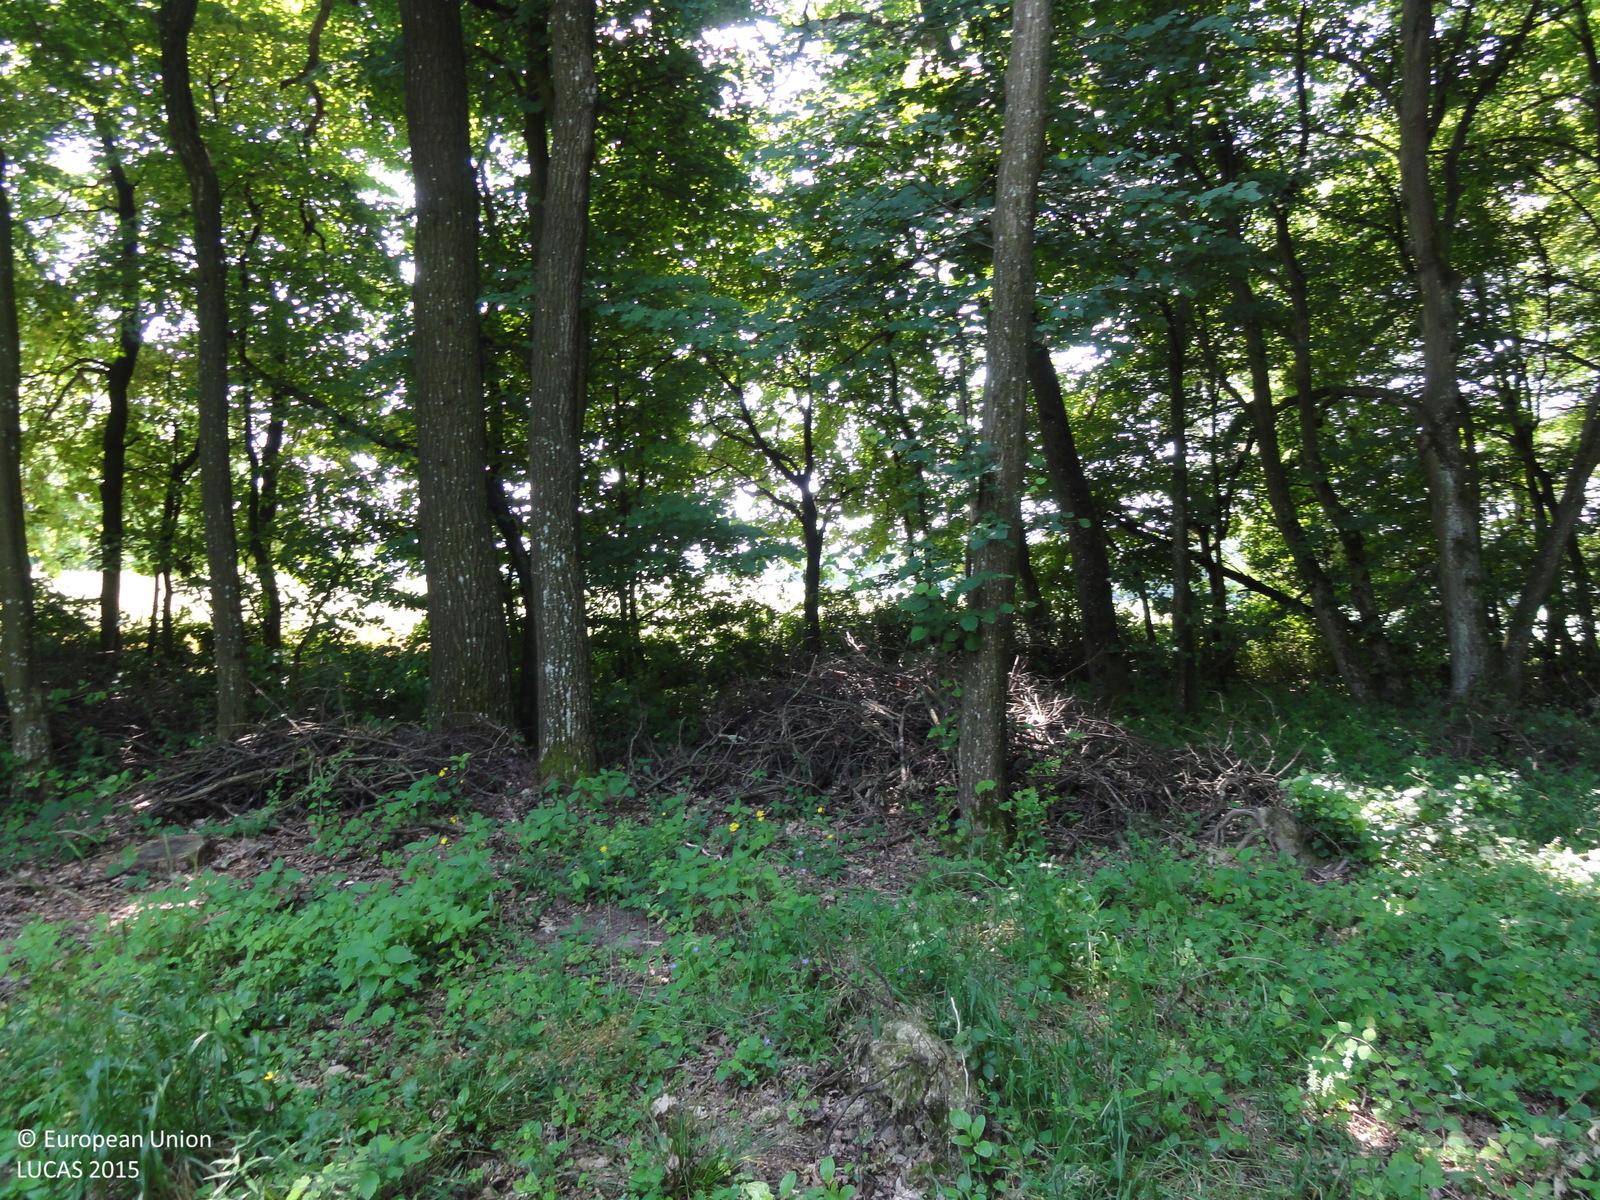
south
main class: Woodland
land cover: Broadleaved woodland
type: mesophytic deciduous forest
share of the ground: 50 - 75 %
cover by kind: broadleaved forest trees 70 %, herbaceous plants 30 %
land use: Forestry
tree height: > 5 m
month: June
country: SI
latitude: 46.6959
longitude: 16.1863
